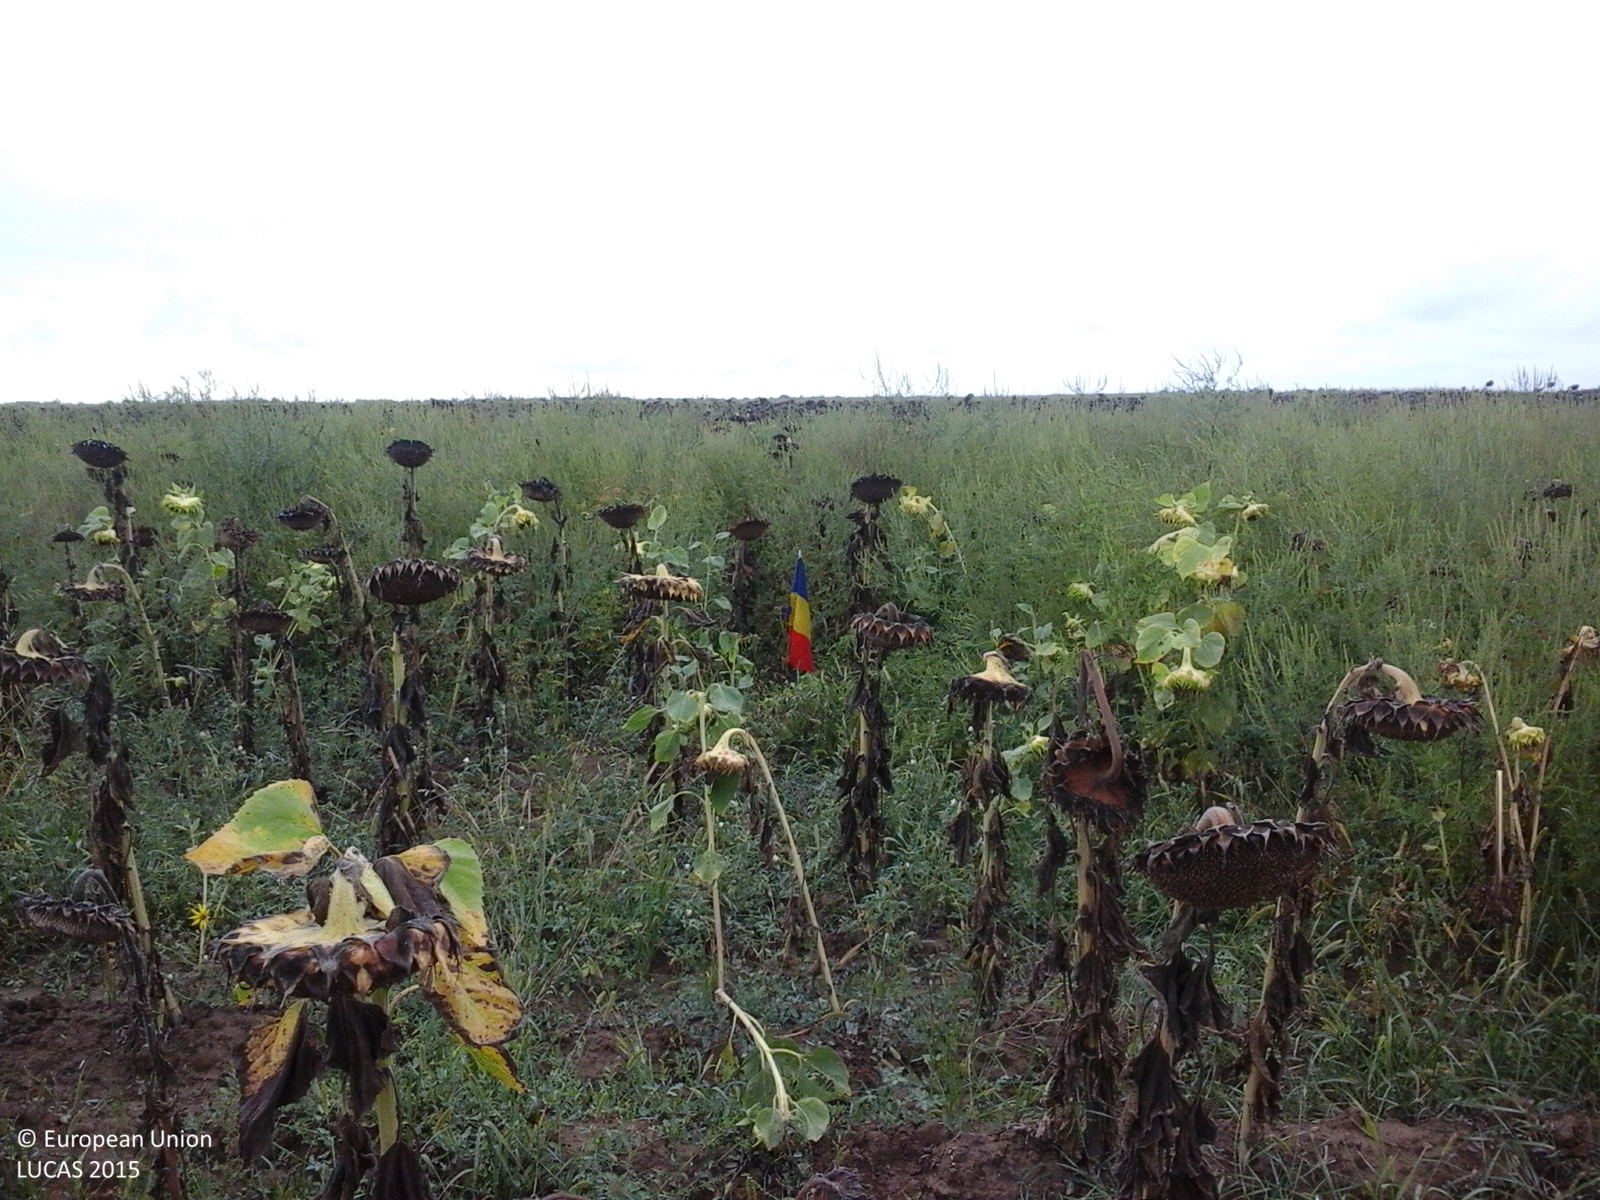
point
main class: Cropland
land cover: Sunflower
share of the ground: 50 - 75 %
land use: Agriculture (excluding fallow land and kitchen gardens)
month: September
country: RO
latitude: 46.9149
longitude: 21.7954
